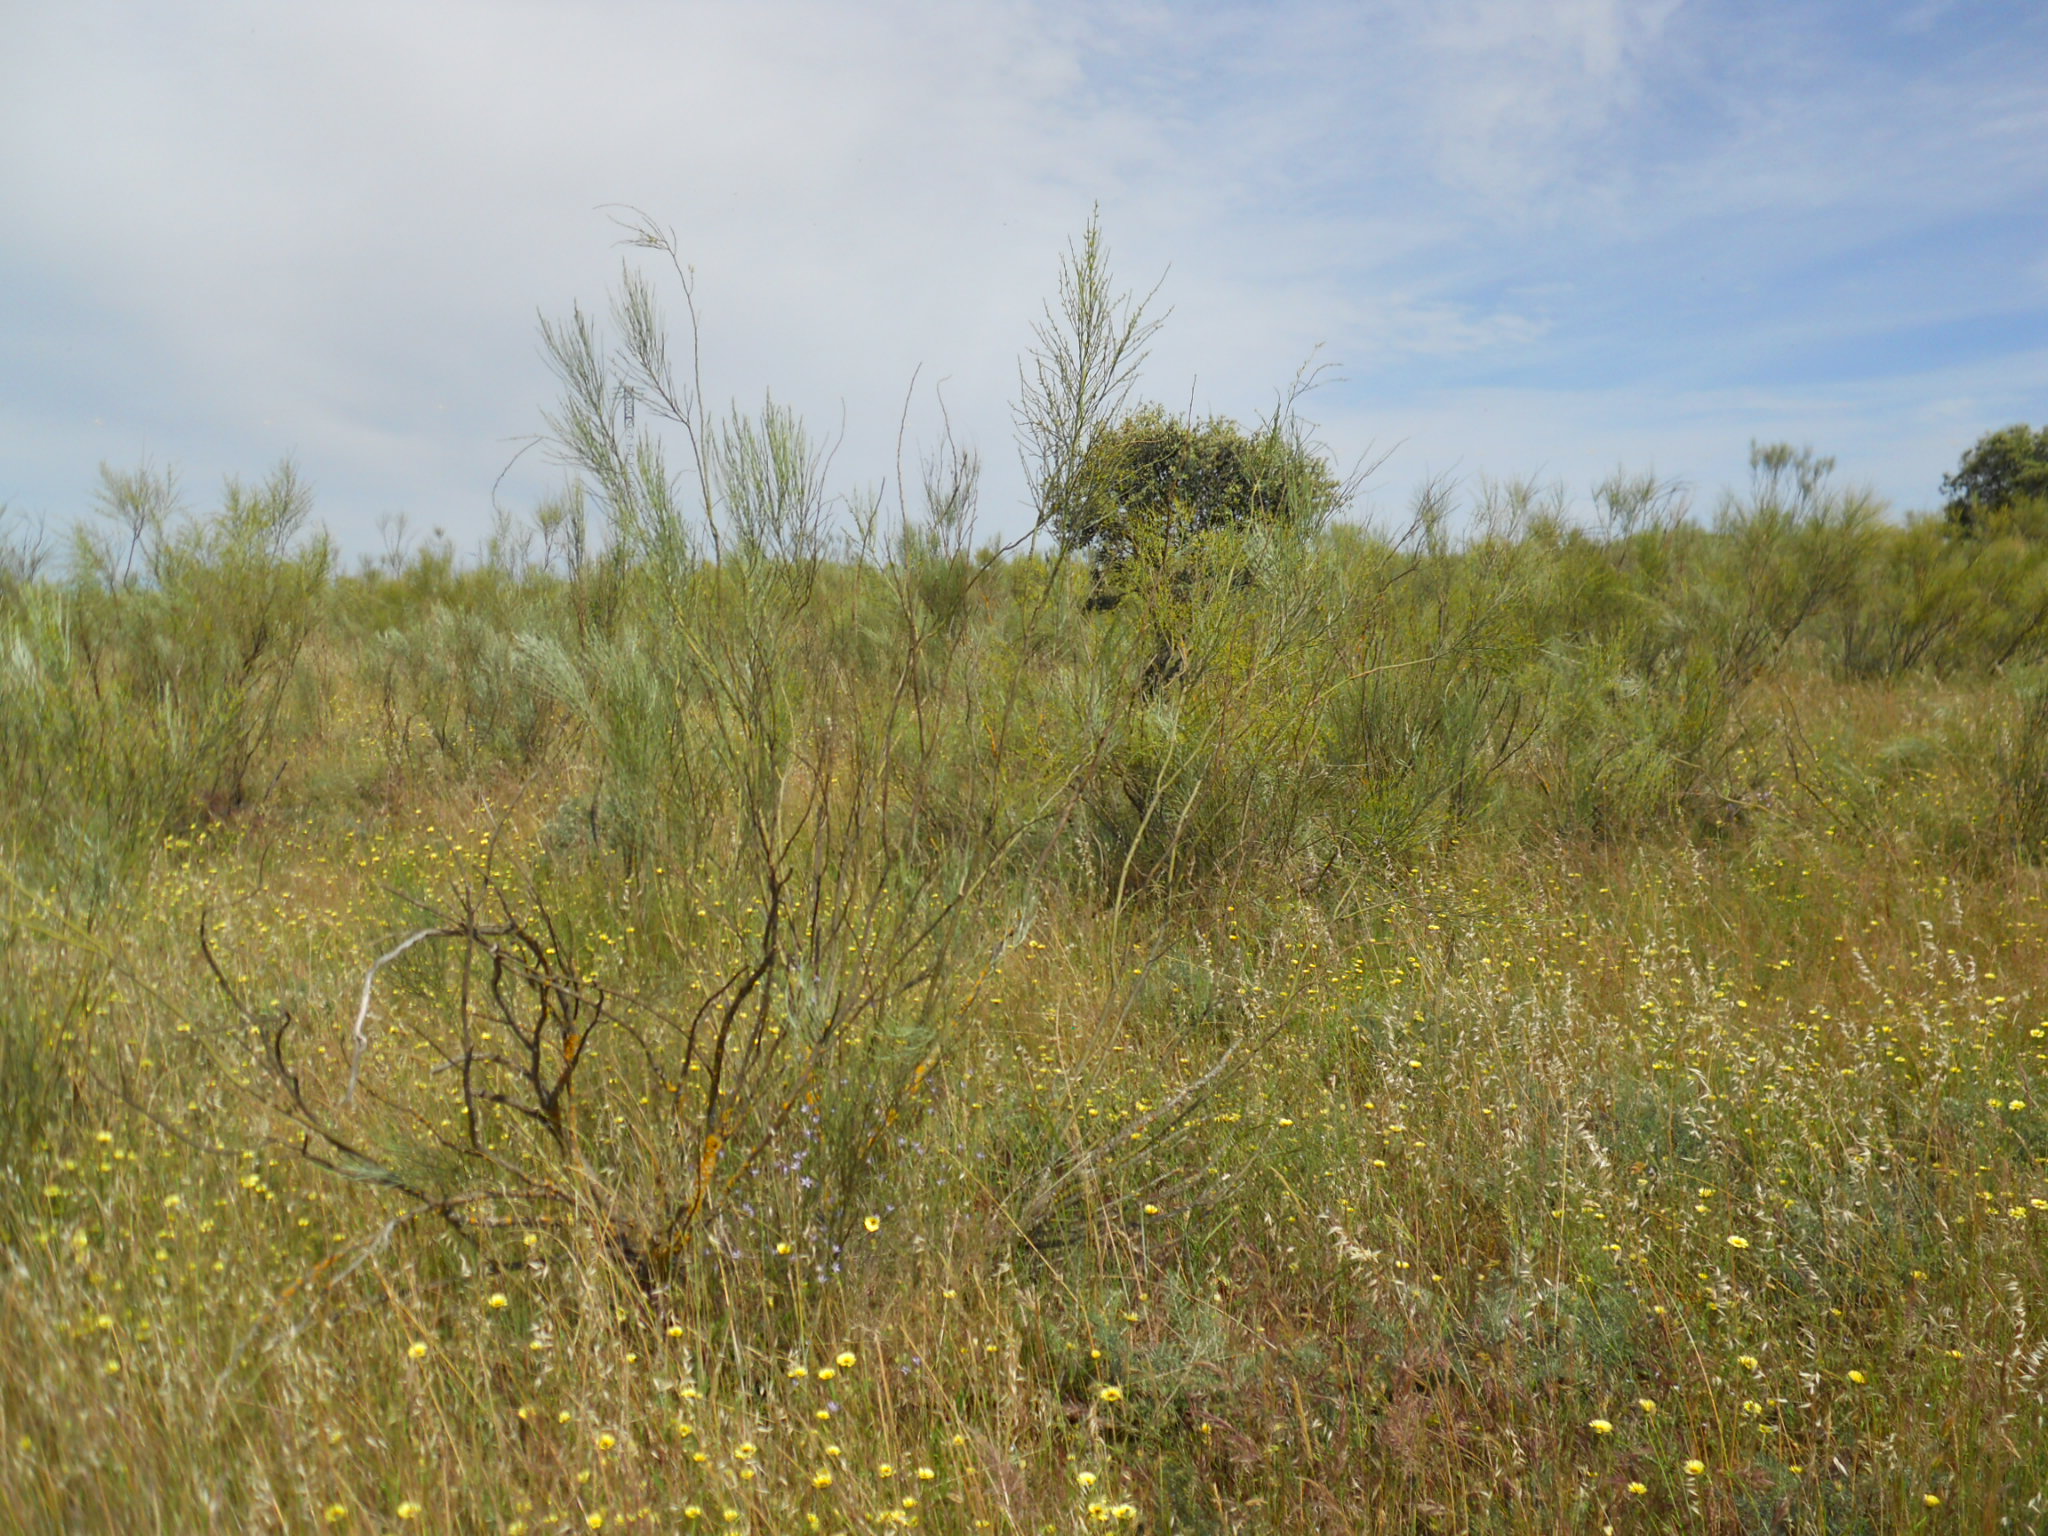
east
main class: Shrubland
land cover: Shrubland with sparse tree cover
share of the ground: 50 - 75 %
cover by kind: shrubs 80 %, herbaceous plants 15 %, broadleaved forest trees 5 %
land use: Agriculture (excluding fallow land and kitchen gardens)
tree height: < 5 m
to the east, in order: Shrubland with sparse tree cover; Electric lines; Shrubland with sparse tree cover; Fences; Tracks; Shrubland without tree cover; Fences; Shrubland with sparse tree cover; Paved roads, cycling and walking lanes; Managed hedges; Paved roads, cycling and walking lanes; Shrubland with sparse tree cover; Fences; Shrubland with sparse tree cover; Paved roads, cycling and walking lanes; Shrubland with sparse tree cover; Other structural elements; Shrubland without tree cover
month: May
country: ES
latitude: 39.3466
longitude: -6.3449
